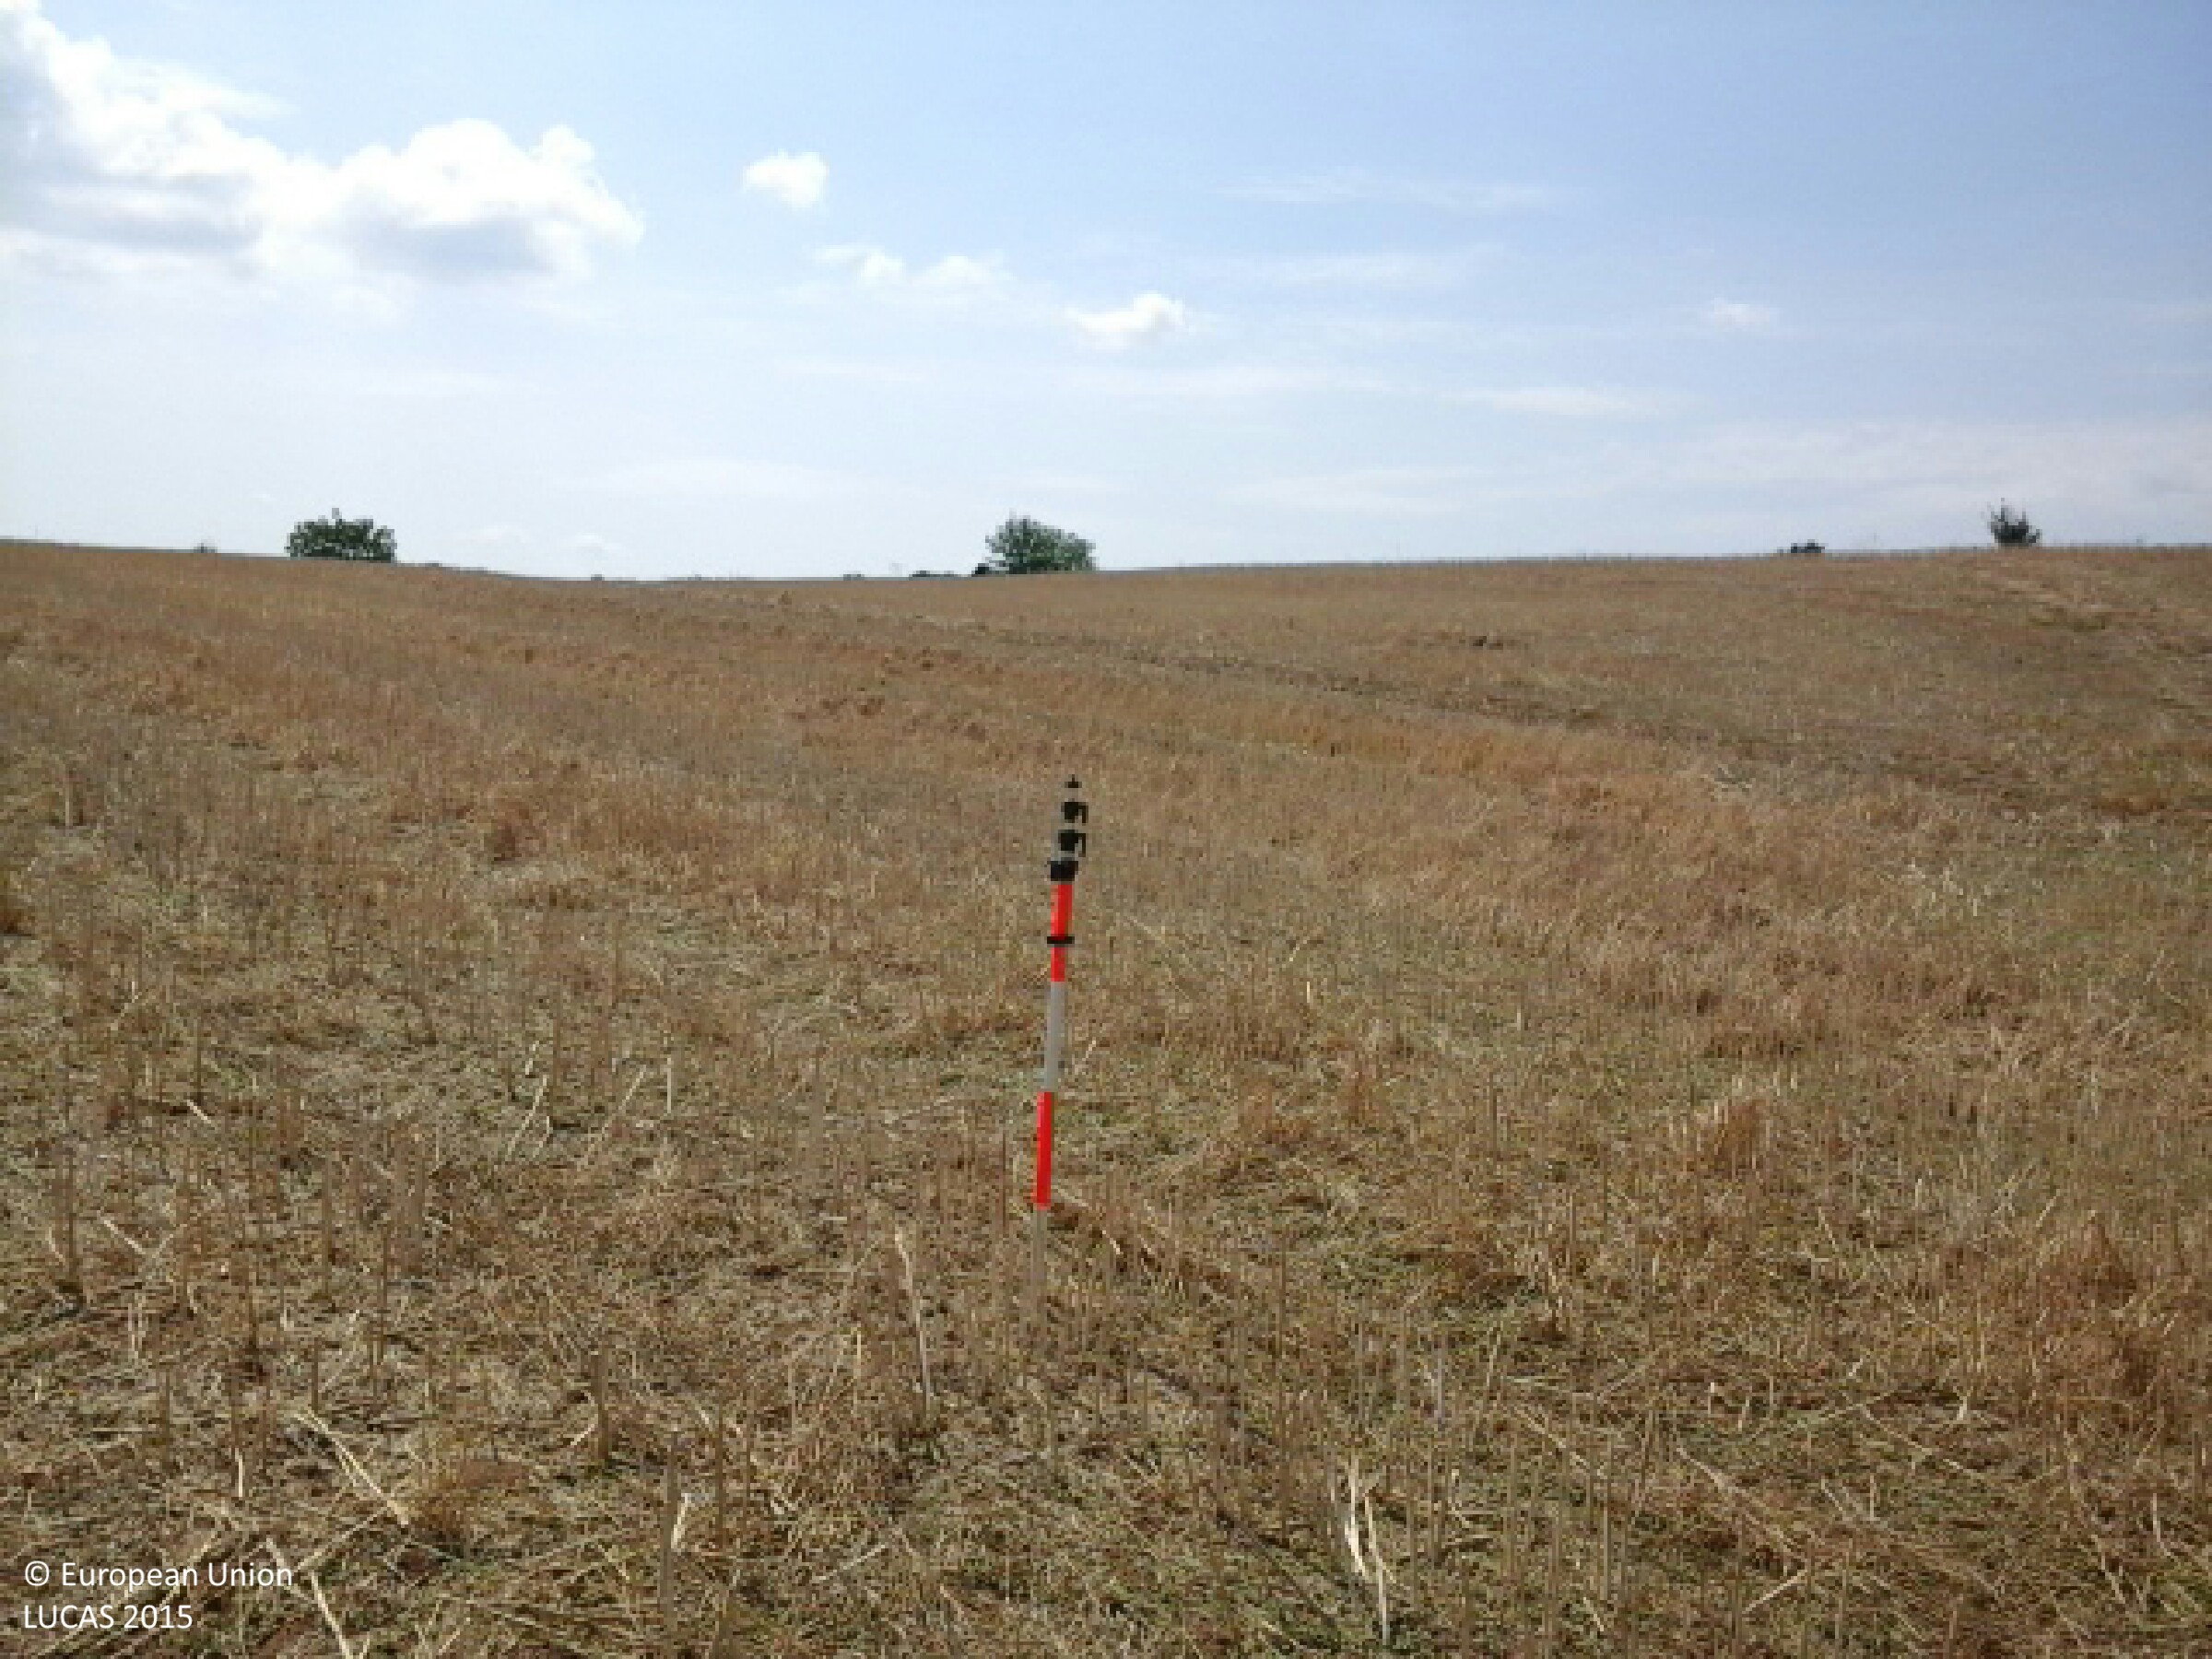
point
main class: Cropland
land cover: Rape and turnip rape
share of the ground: 10 - 25 %
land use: Agriculture (excluding fallow land and kitchen gardens)
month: August
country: HU
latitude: 47.5822
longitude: 18.5638
